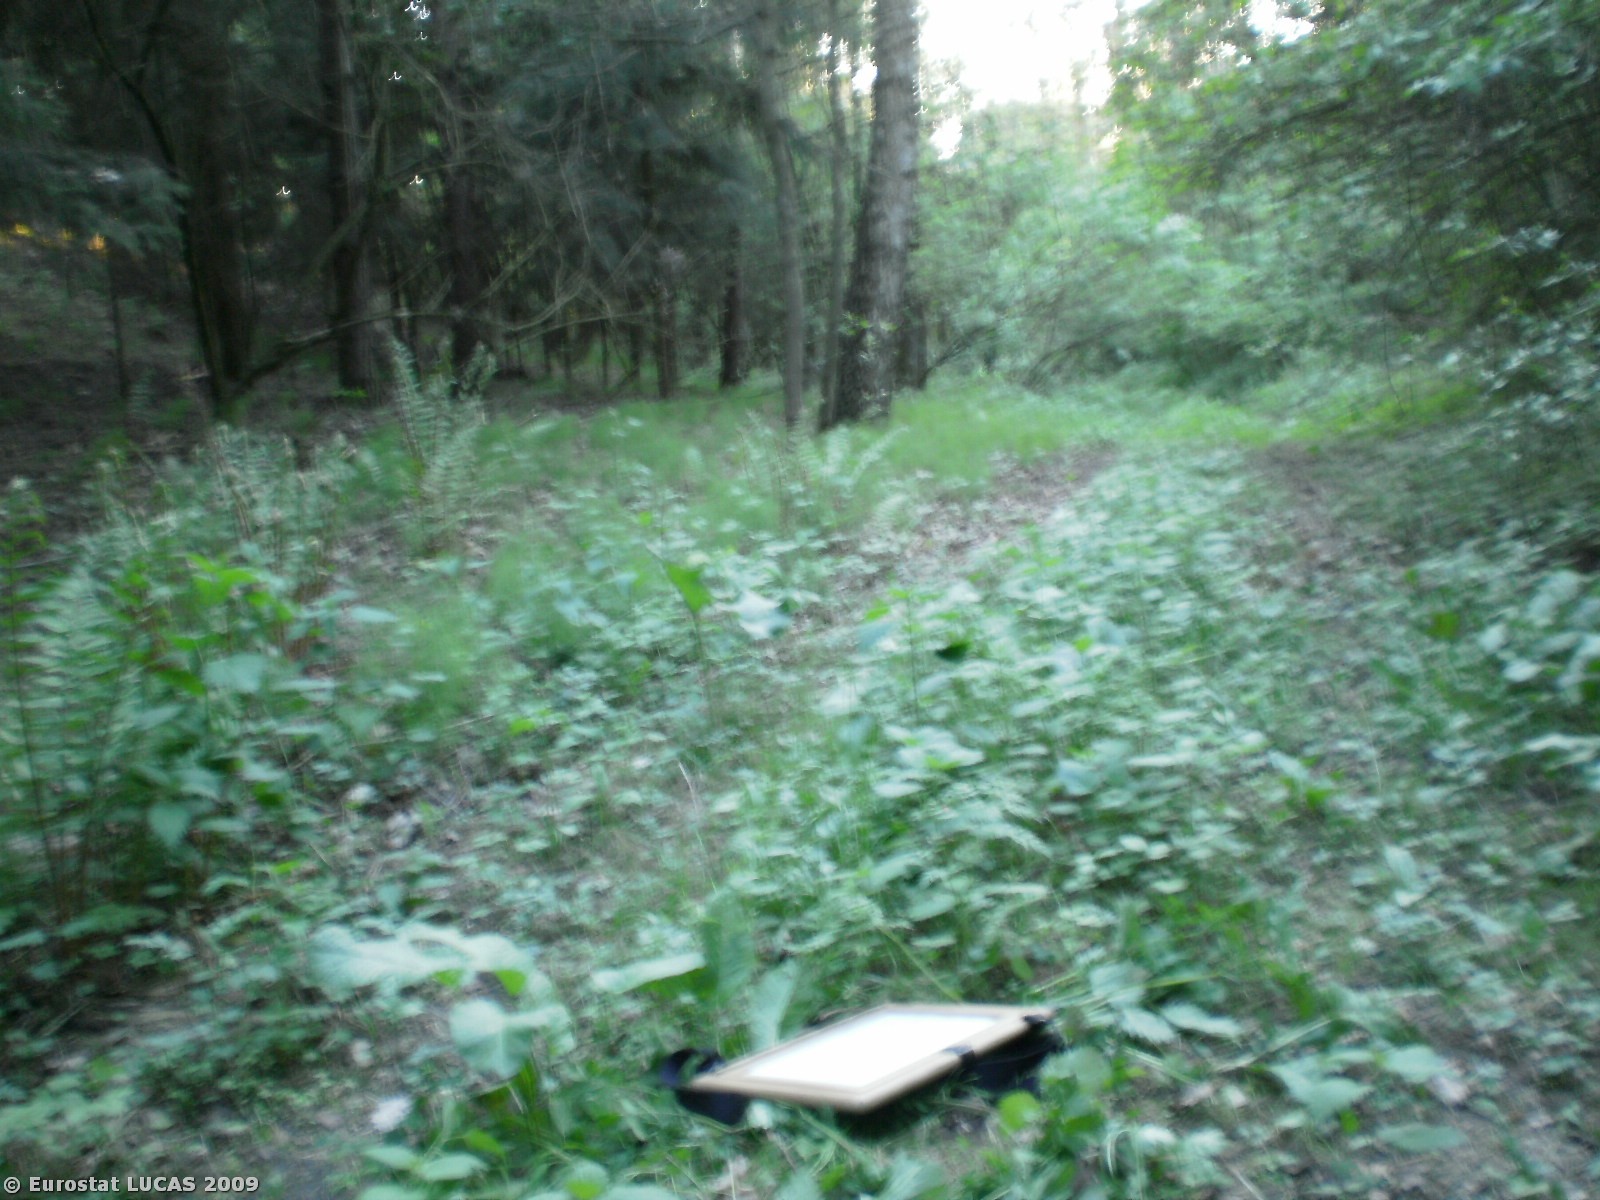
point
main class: Woodland
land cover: Coniferous woodland
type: hemiboreal forest and nemoral coniferous forest and mixed broadleaved-coniferous forest
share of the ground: < 10 %
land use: Forestry
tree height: > 5 m
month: May
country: PL
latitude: 53.4230
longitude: 18.8241
